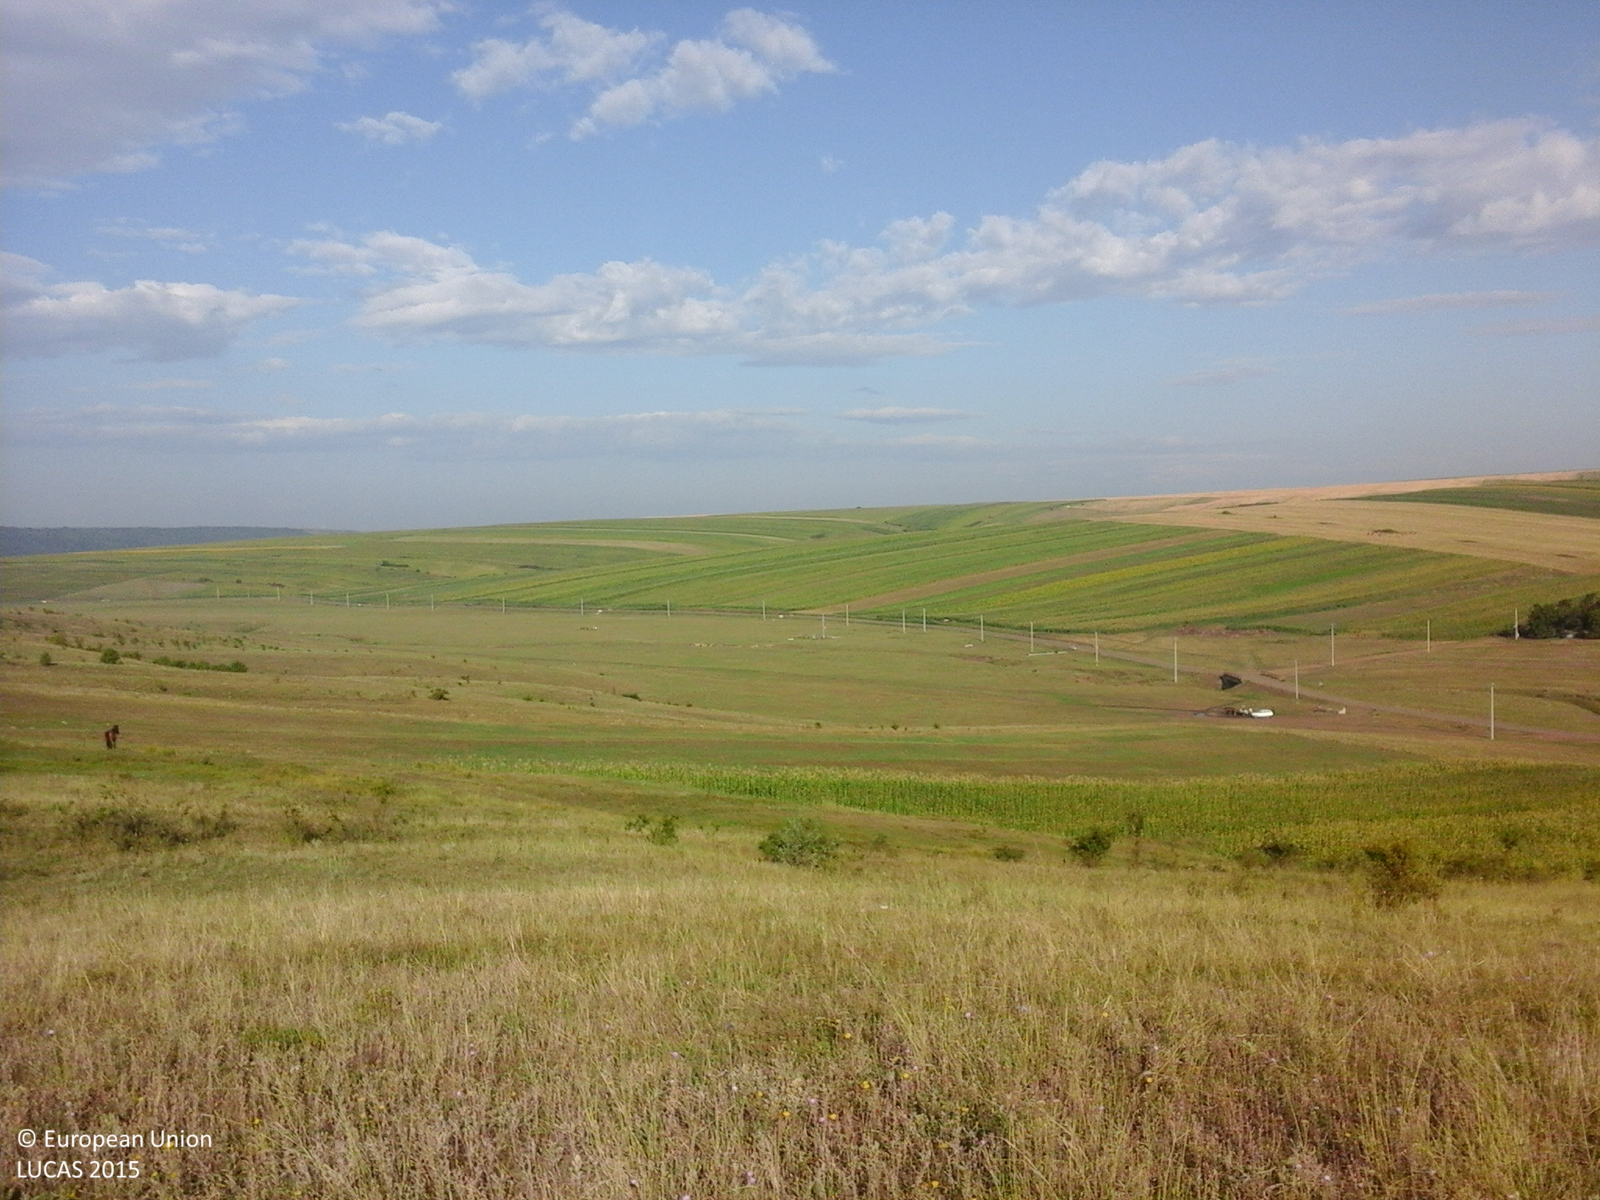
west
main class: Grassland
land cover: Grassland without tree/shrub cover
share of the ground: > 75 %
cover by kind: herbaceous plants 100 %
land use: Agriculture (excluding fallow land and kitchen gardens)
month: July
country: RO
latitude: 46.1959
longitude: 27.7522
